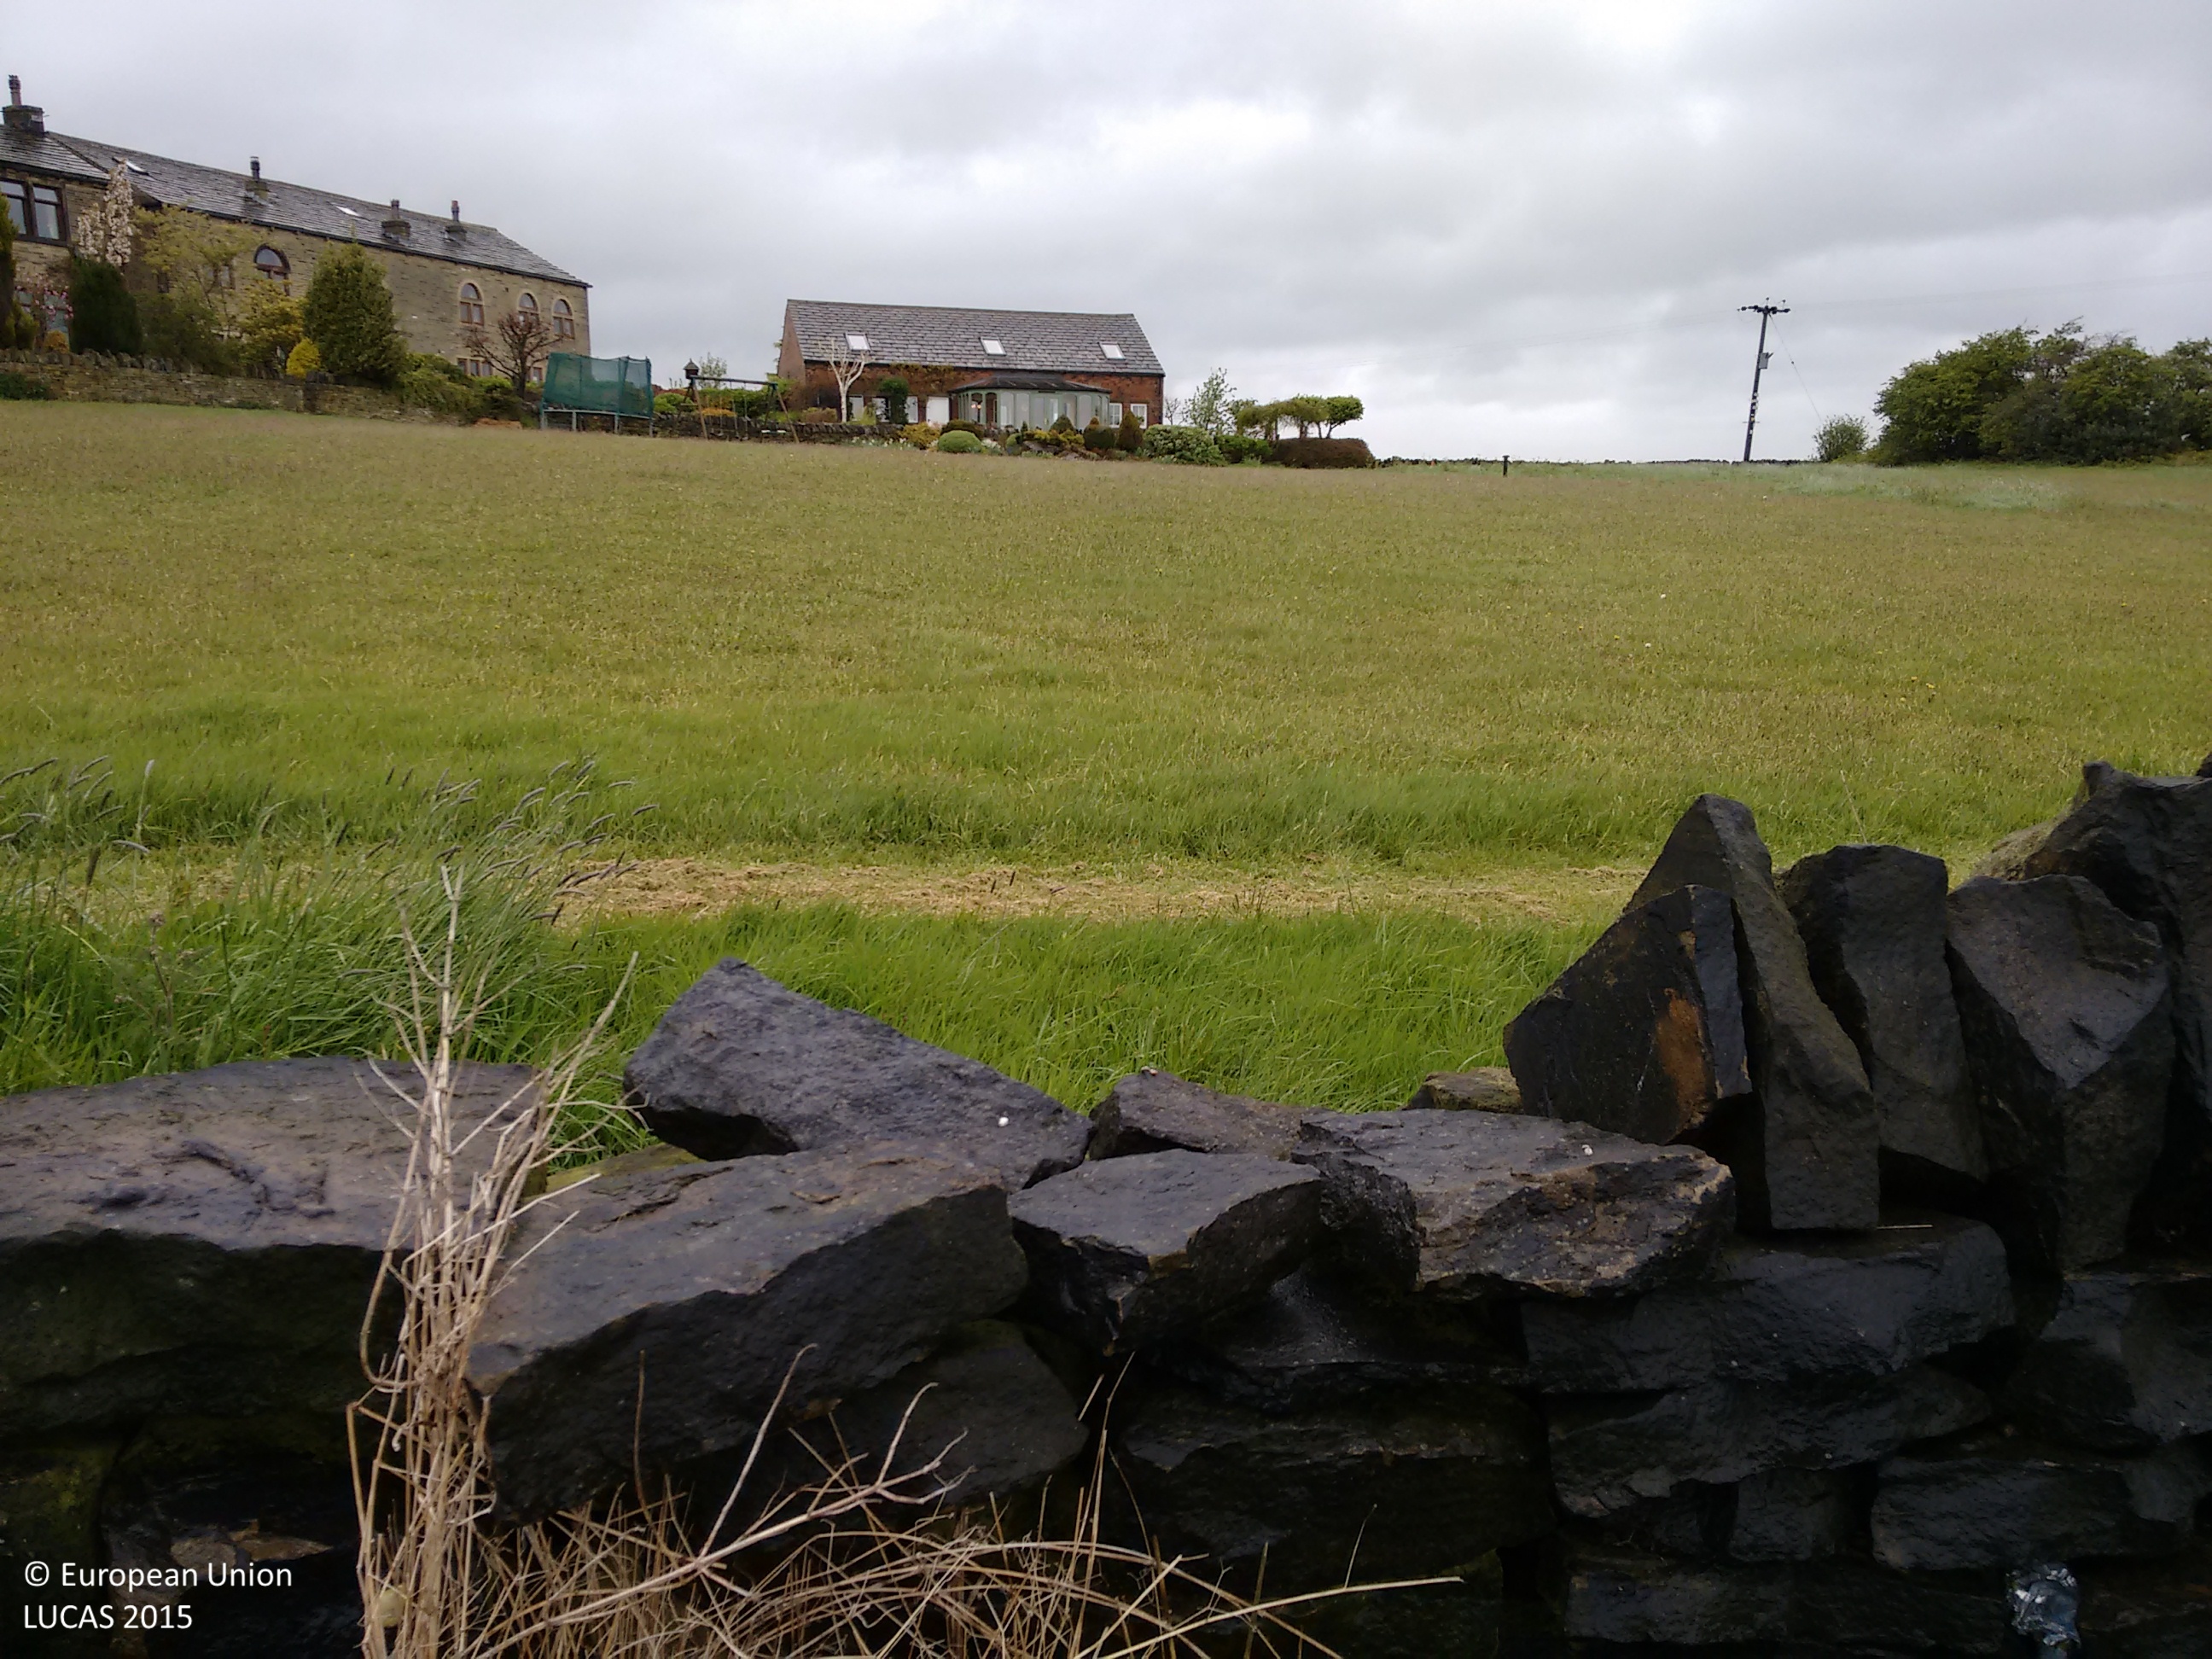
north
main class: Grassland
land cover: Grassland without tree/shrub cover
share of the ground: > 75 %
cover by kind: herbaceous plants 100 %
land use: Agriculture (excluding fallow land and kitchen gardens)
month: May
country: GB
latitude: 53.7108
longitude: -1.8267
